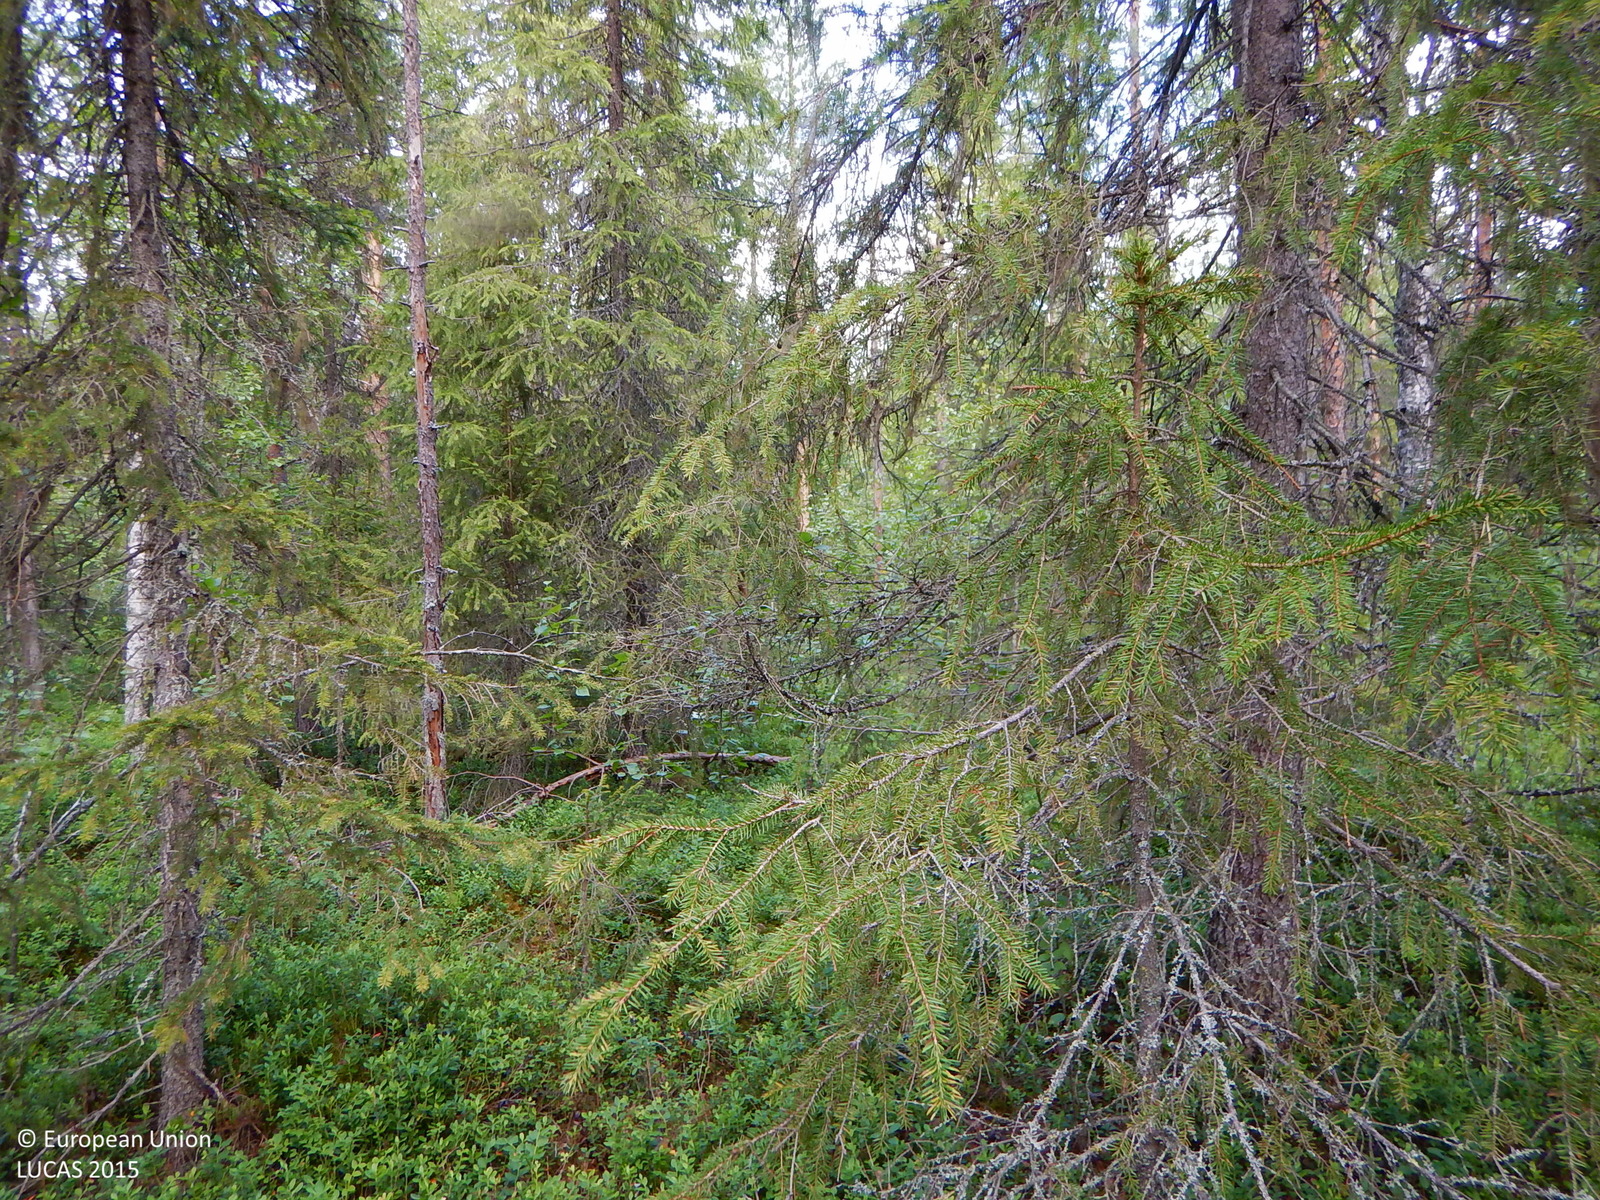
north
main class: Woodland
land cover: Other coniferous woodland
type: boreal forest
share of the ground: 50 - 75 %
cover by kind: coniferous forest trees 60 %, shrubs 15 %, herbaceous plants 10 %, lichens and mosses 10 %, broadleaved forest trees 5 %
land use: Forestry
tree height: > 5 m
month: July
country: SE
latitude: 64.8712
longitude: 20.2077
